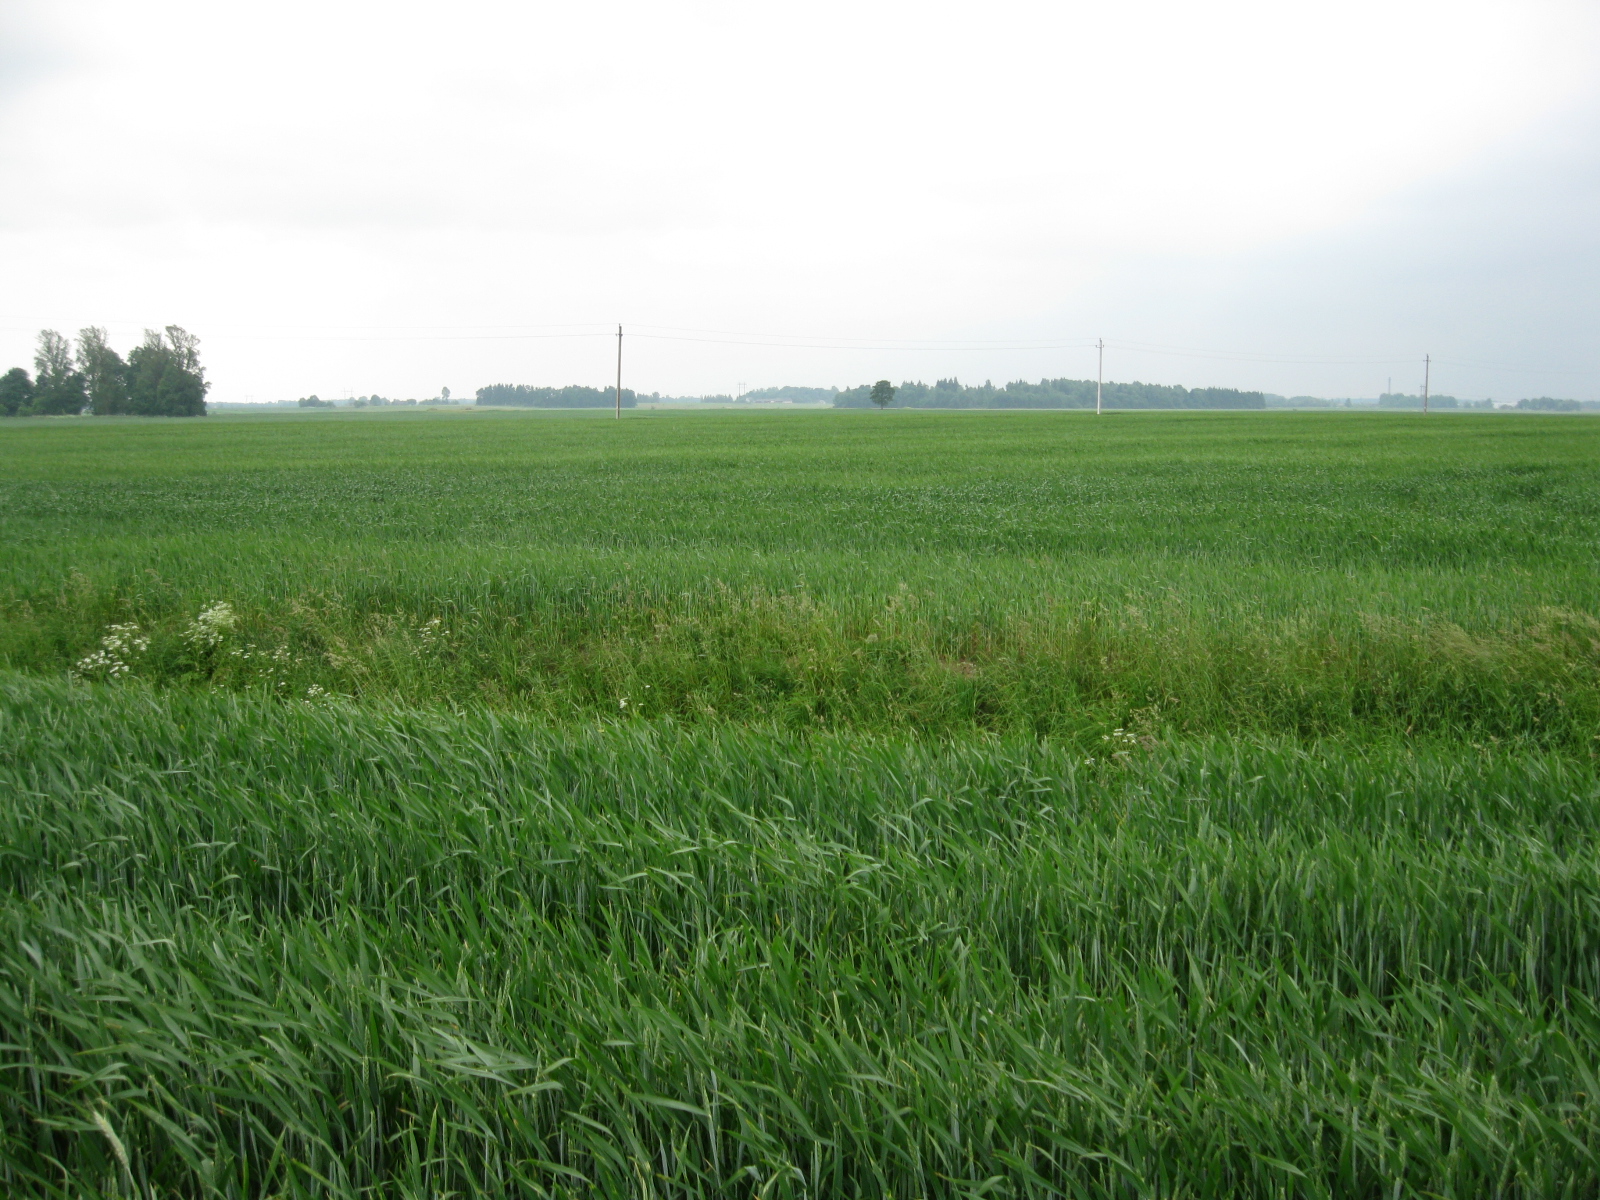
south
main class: Cropland
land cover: Common wheat
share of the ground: > 75 %
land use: Agriculture (excluding fallow land and kitchen gardens)
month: June
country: LT
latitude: 55.2862
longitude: 23.5108
